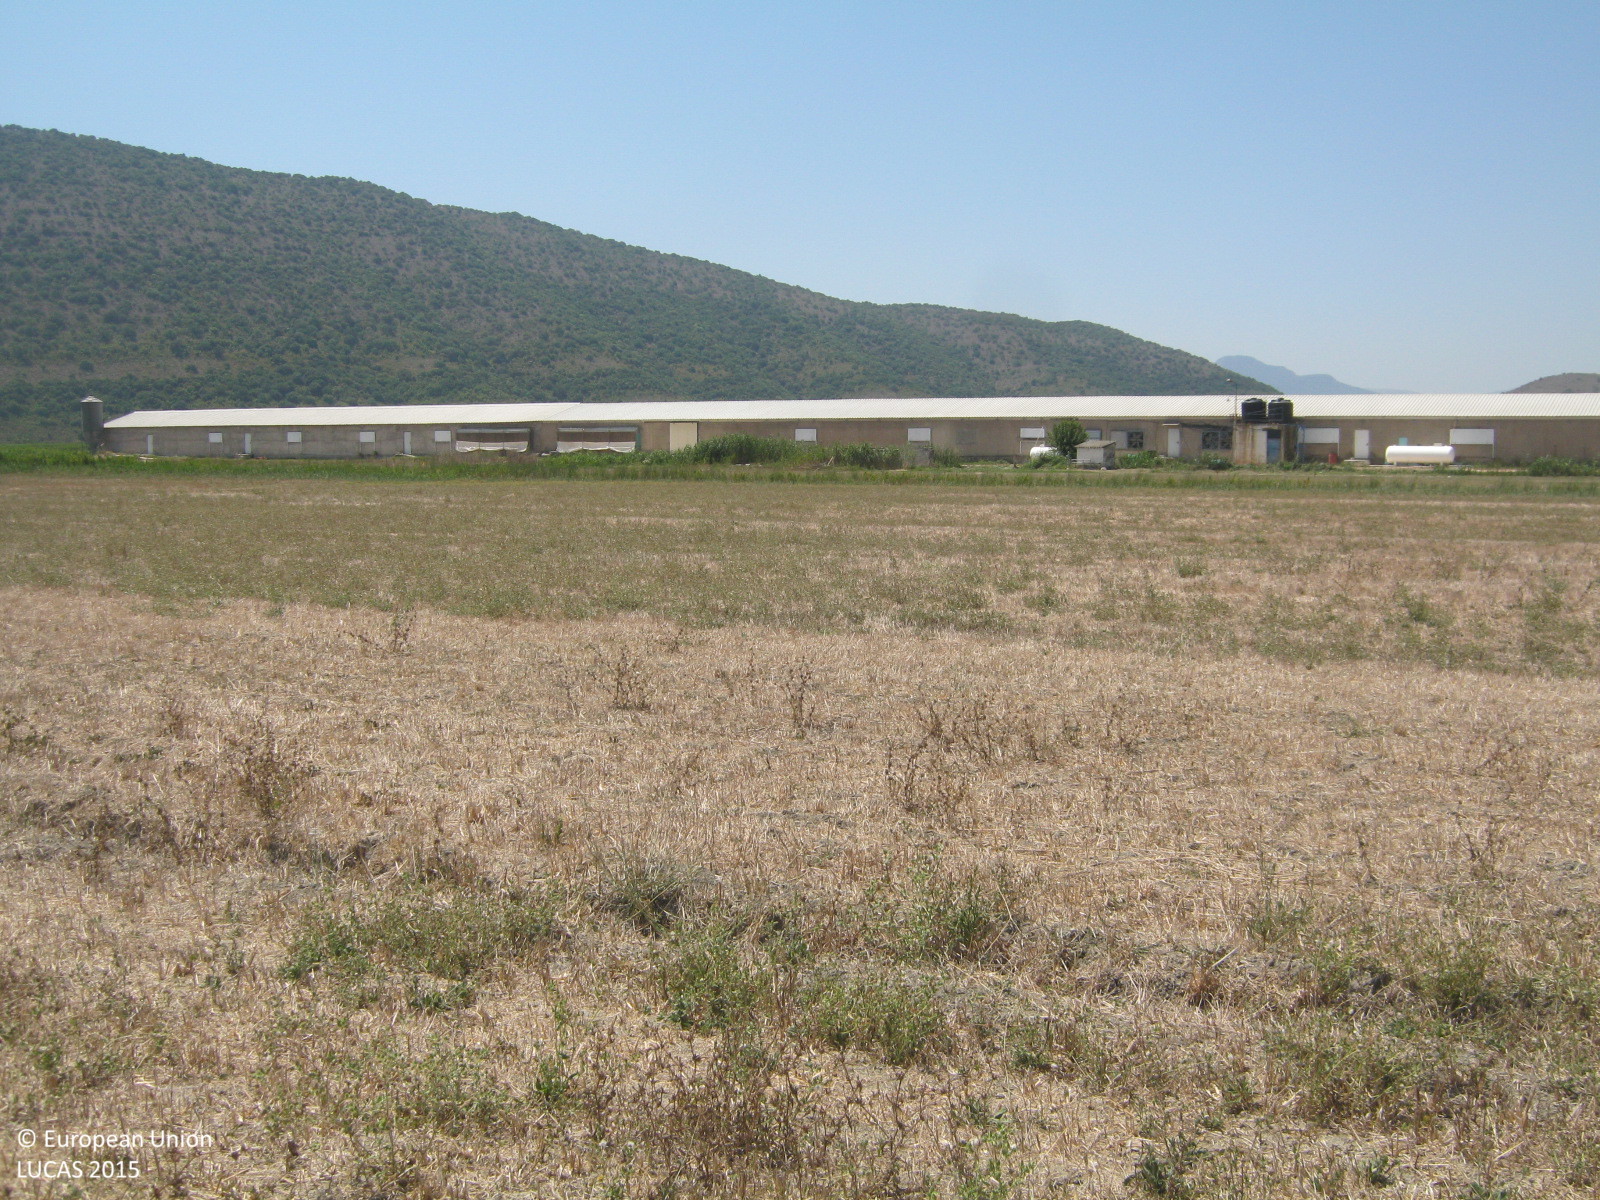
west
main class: Grassland
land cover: Spontaneously vegetated surfaces
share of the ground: > 75 %
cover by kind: herbaceous plants 100 %
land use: Fallow land
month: July
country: GR
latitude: 39.1157
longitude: 20.8558
